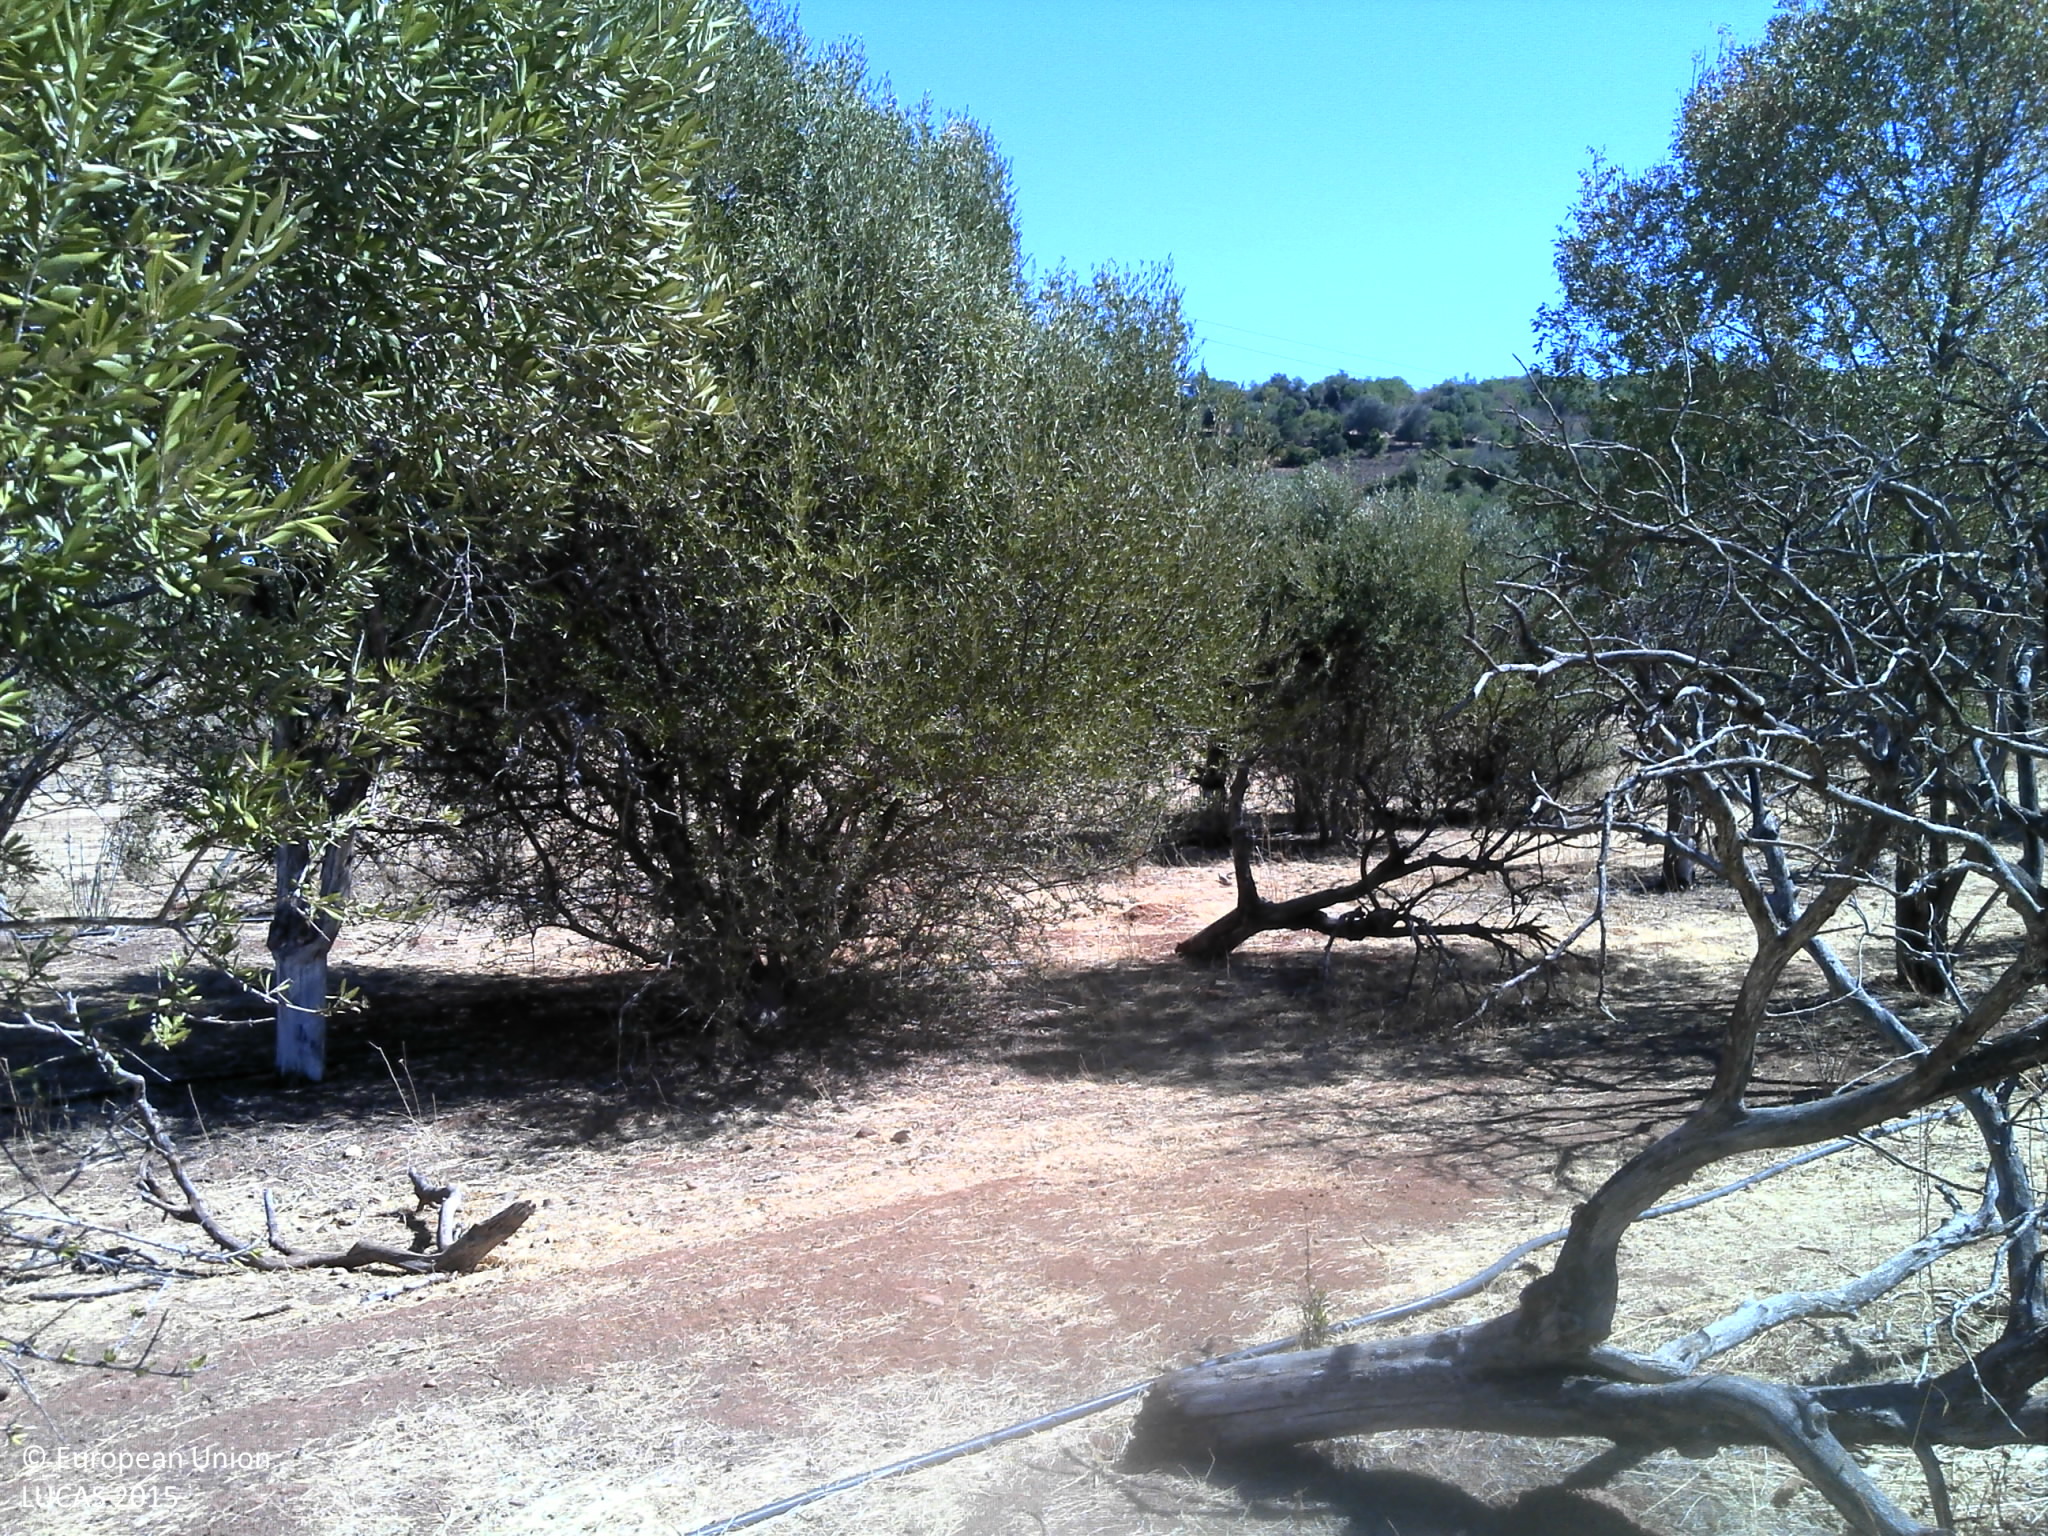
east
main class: Cropland
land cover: Olive groves
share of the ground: 50 - 75 %
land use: Agriculture (excluding fallow land and kitchen gardens)
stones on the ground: < 10 %
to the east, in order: Olive groves; Fences; Electric lines; Grassland without tree/shrub cover; Tracks; Oranges; Other fruit trees and berries; Tracks; Nuts trees; Olive groves; Other bare soil; Olive groves; Permanent industrial crops; Oranges; Permanent industrial crops; Grassland without tree/shrub cover; Fences; Grassland without tree/shrub cover
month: September
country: PT
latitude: 37.1819
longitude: -8.1867
